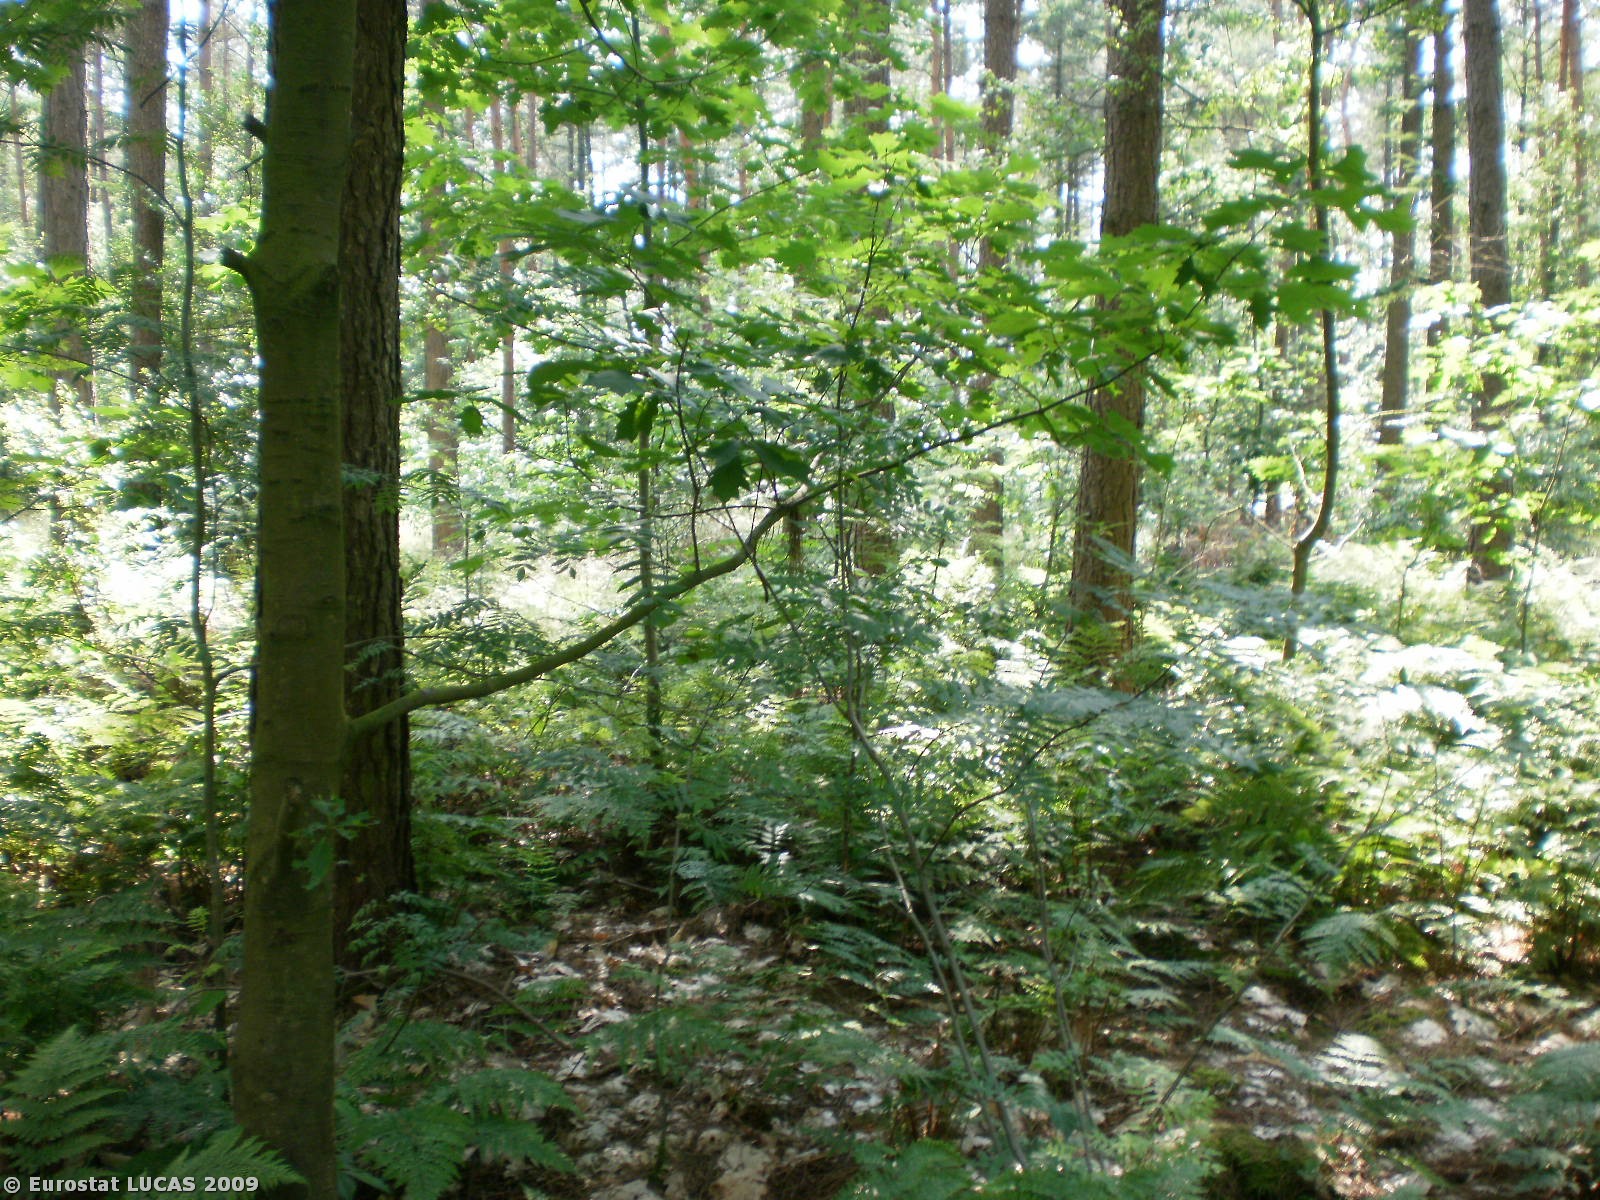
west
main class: Woodland
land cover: Mixed woodland
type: hemiboreal forest and nemoral coniferous forest and mixed broadleaved-coniferous forest
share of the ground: > 75 %
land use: Nature reserves
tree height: > 5 m
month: June
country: BE
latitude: 51.0299
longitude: 5.4495
